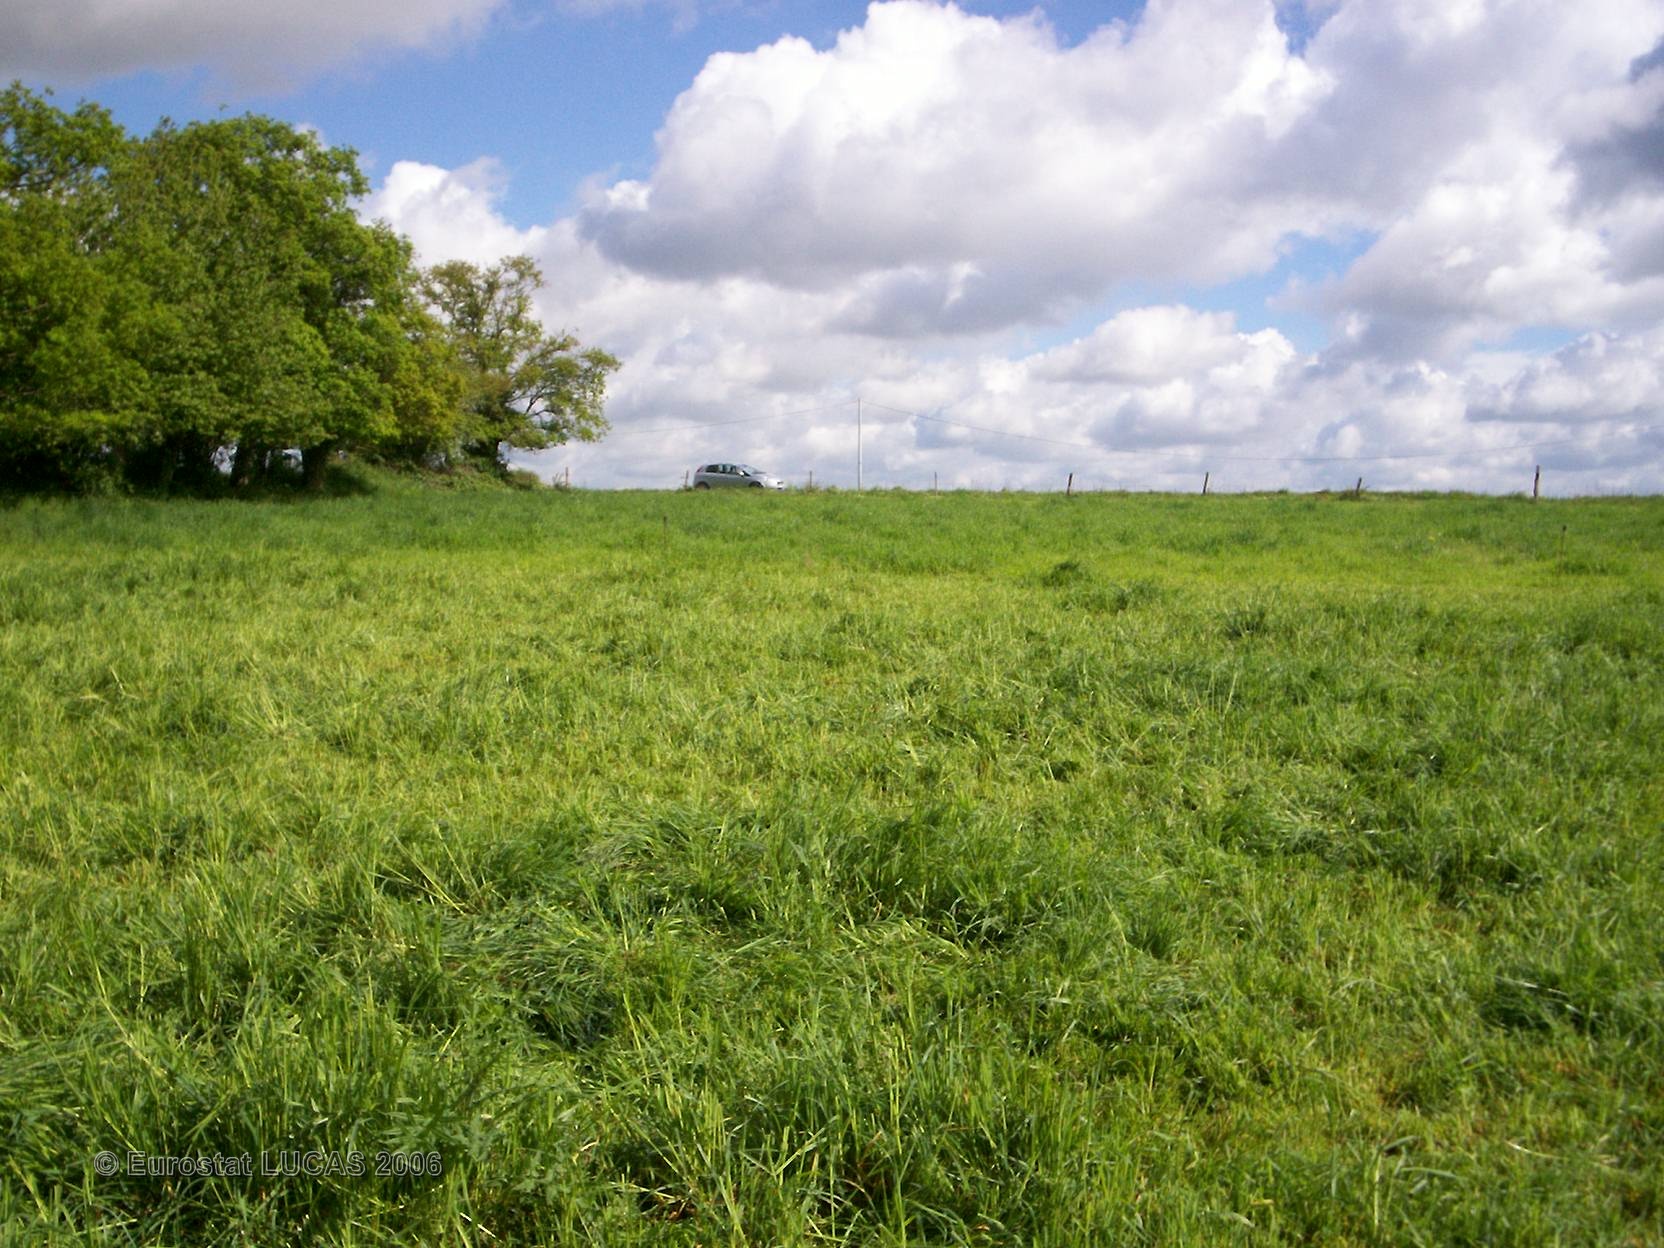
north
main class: Grassland
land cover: Grassland without tree/shrub cover
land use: Agriculture (excluding fallow land and kitchen gardens)
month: May
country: FR
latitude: 47.8260
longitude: -1.0861
